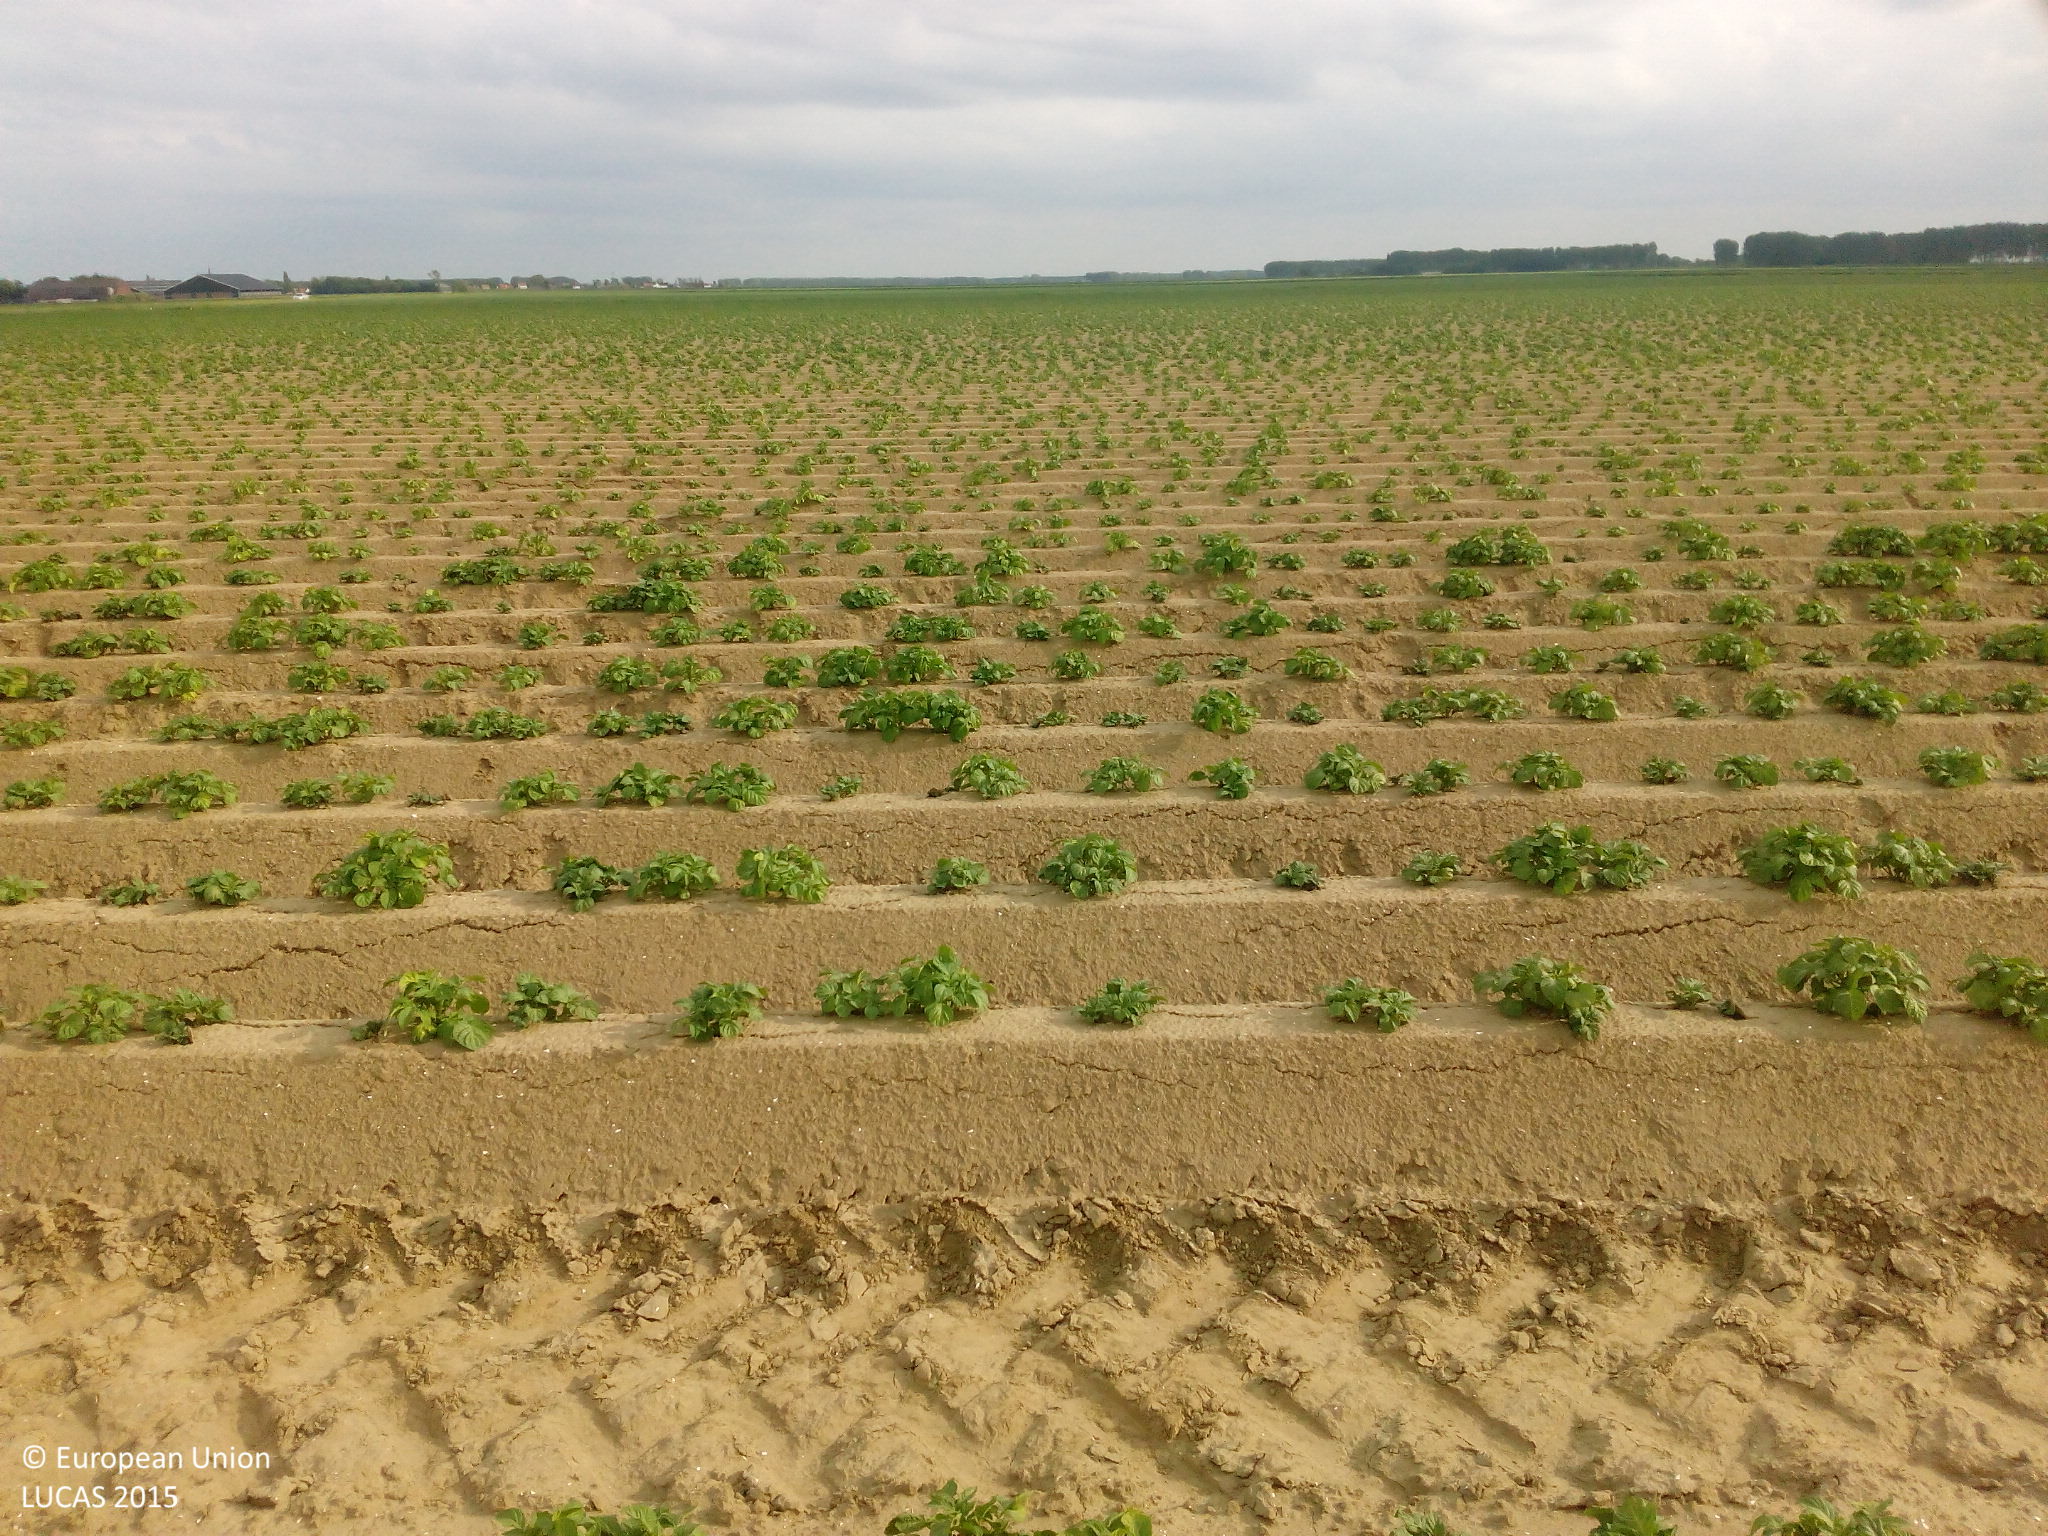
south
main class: Cropland
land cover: Potatoes
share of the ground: < 10 %
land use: Agriculture (excluding fallow land and kitchen gardens)
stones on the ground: < 10 %
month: May
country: NL
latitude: 51.3472
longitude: 4.0936
